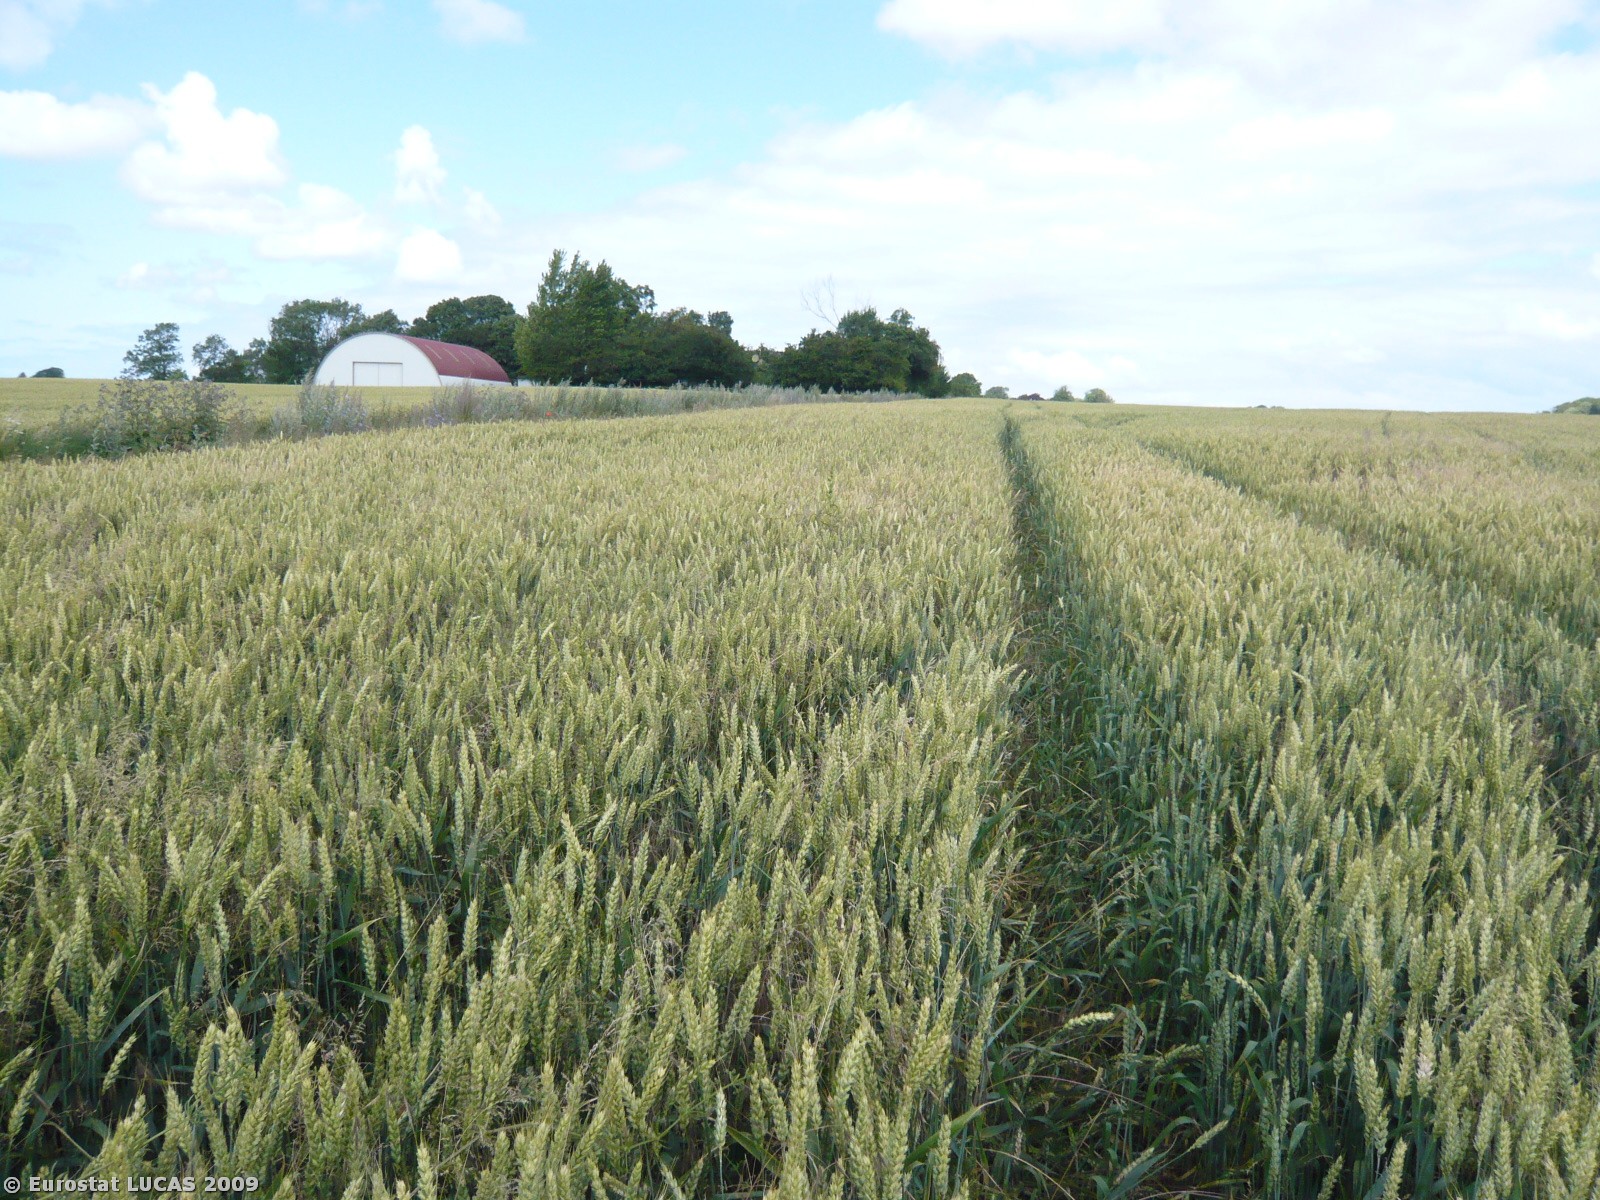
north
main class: Cropland
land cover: Common wheat
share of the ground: > 75 %
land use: Agriculture (excluding fallow land and kitchen gardens)
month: July
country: DK
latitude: 55.6612
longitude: 11.1593
